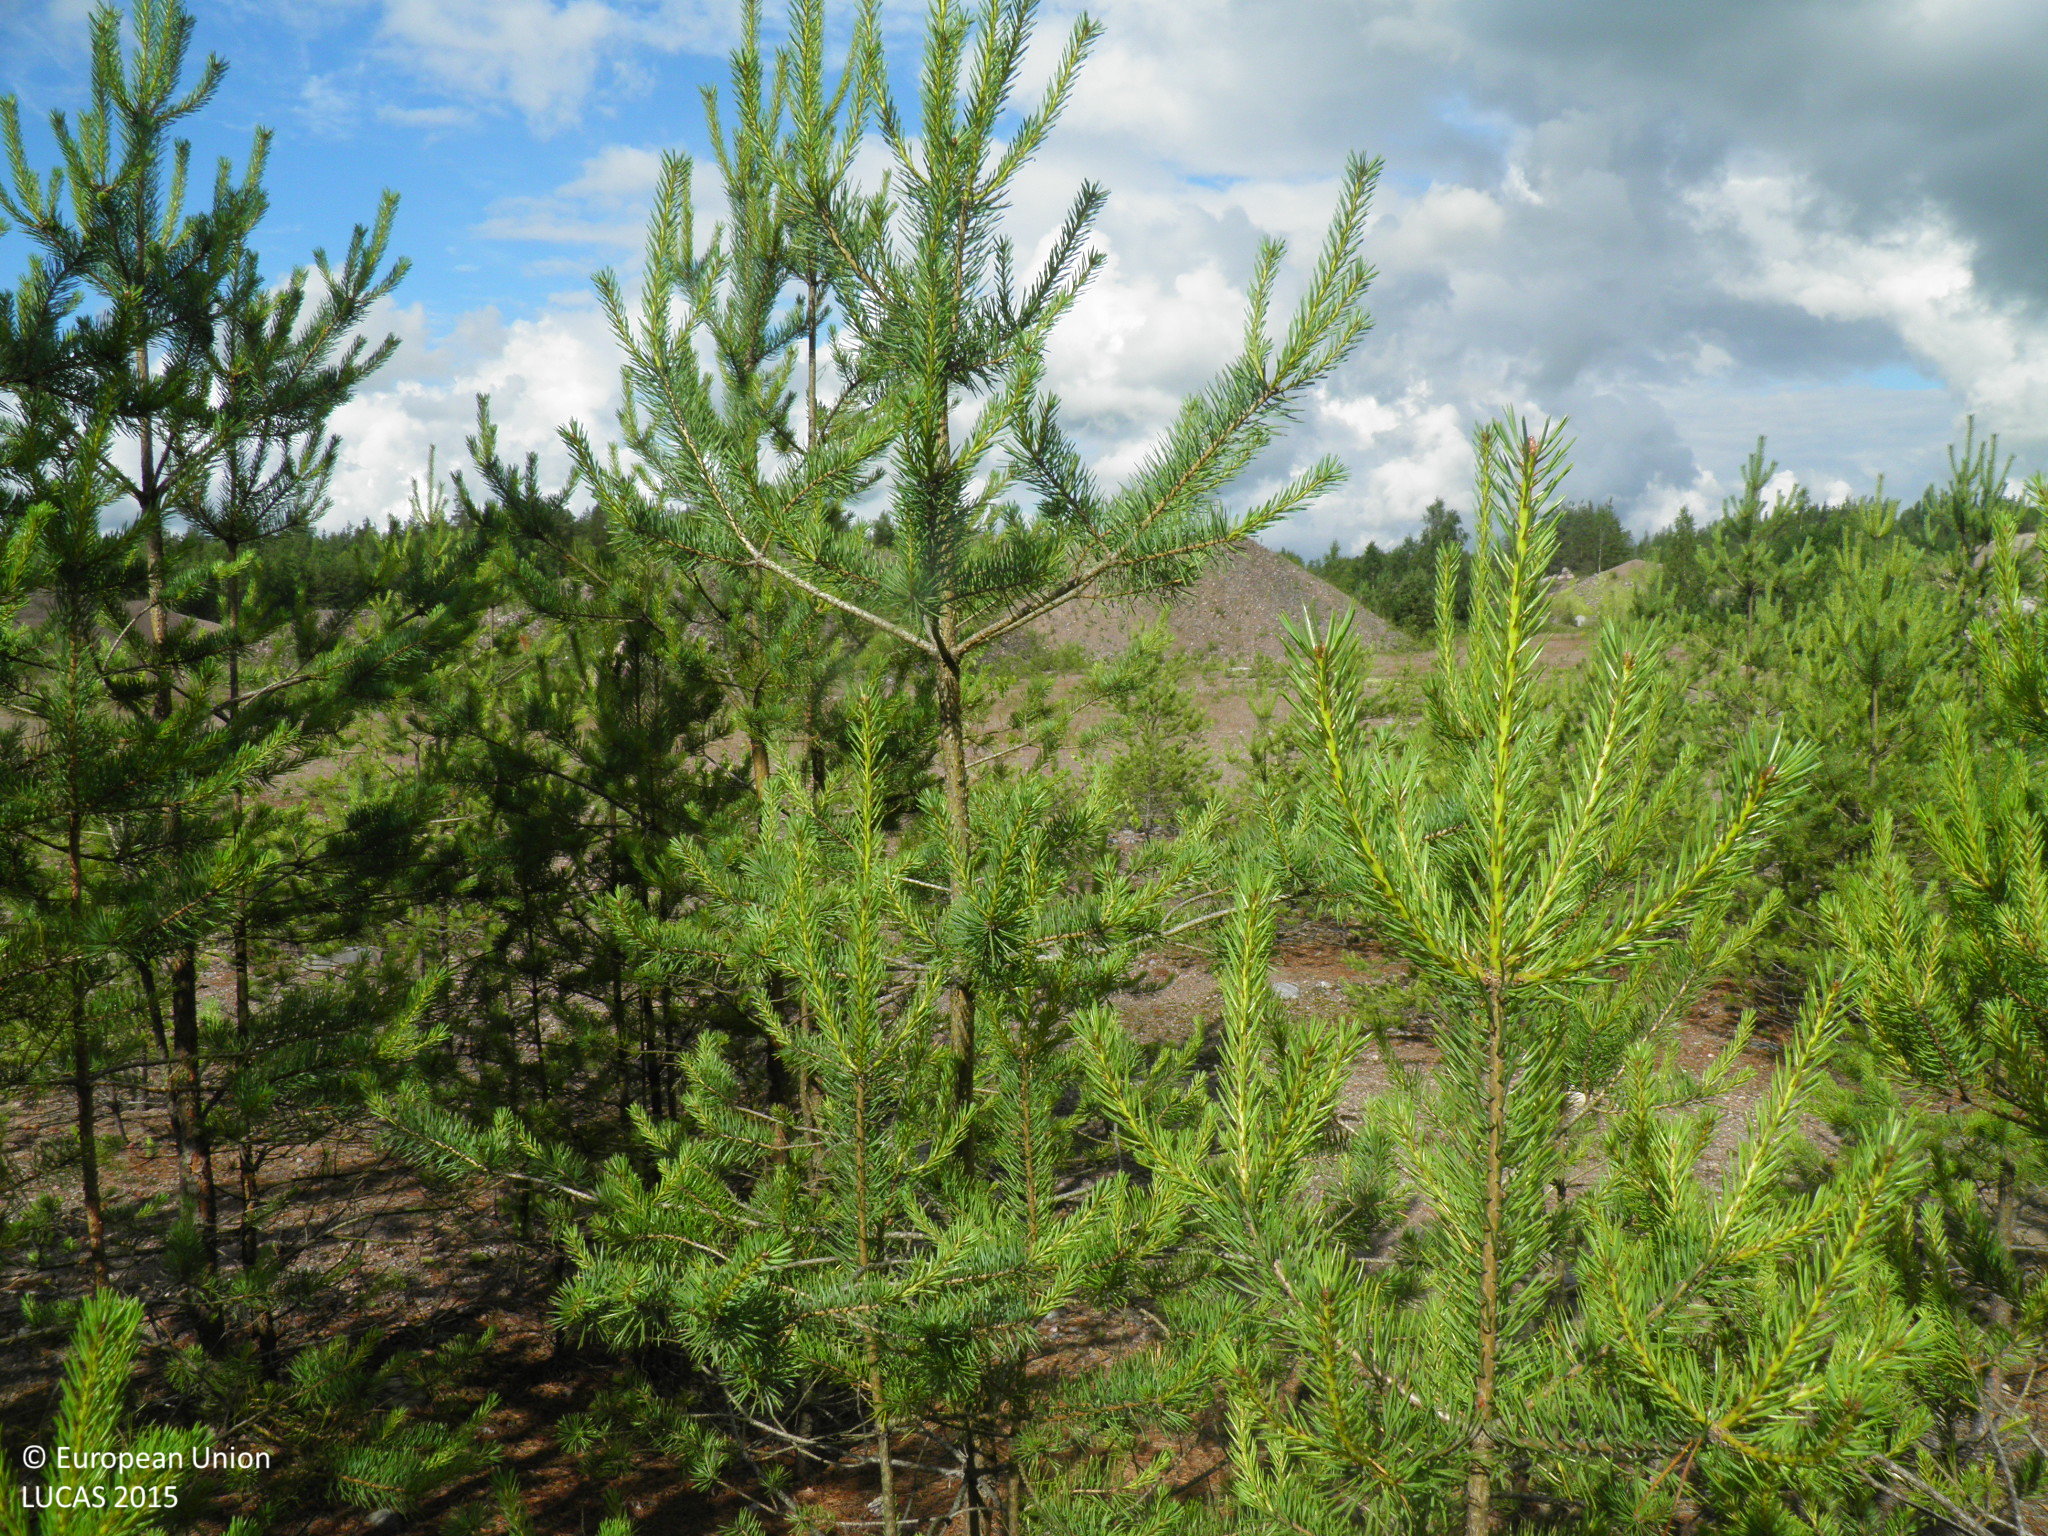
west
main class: Woodland
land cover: Pine dominated coniferous woodland
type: boreal forest
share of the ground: 25 - 50 %
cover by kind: coniferous forest trees 40 %, consolidated bare surface 30 %, unconsolidated bare surface 30 %
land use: Abandoned areas
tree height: < 5 m
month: July
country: FI
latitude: 60.8210
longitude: 22.7782
